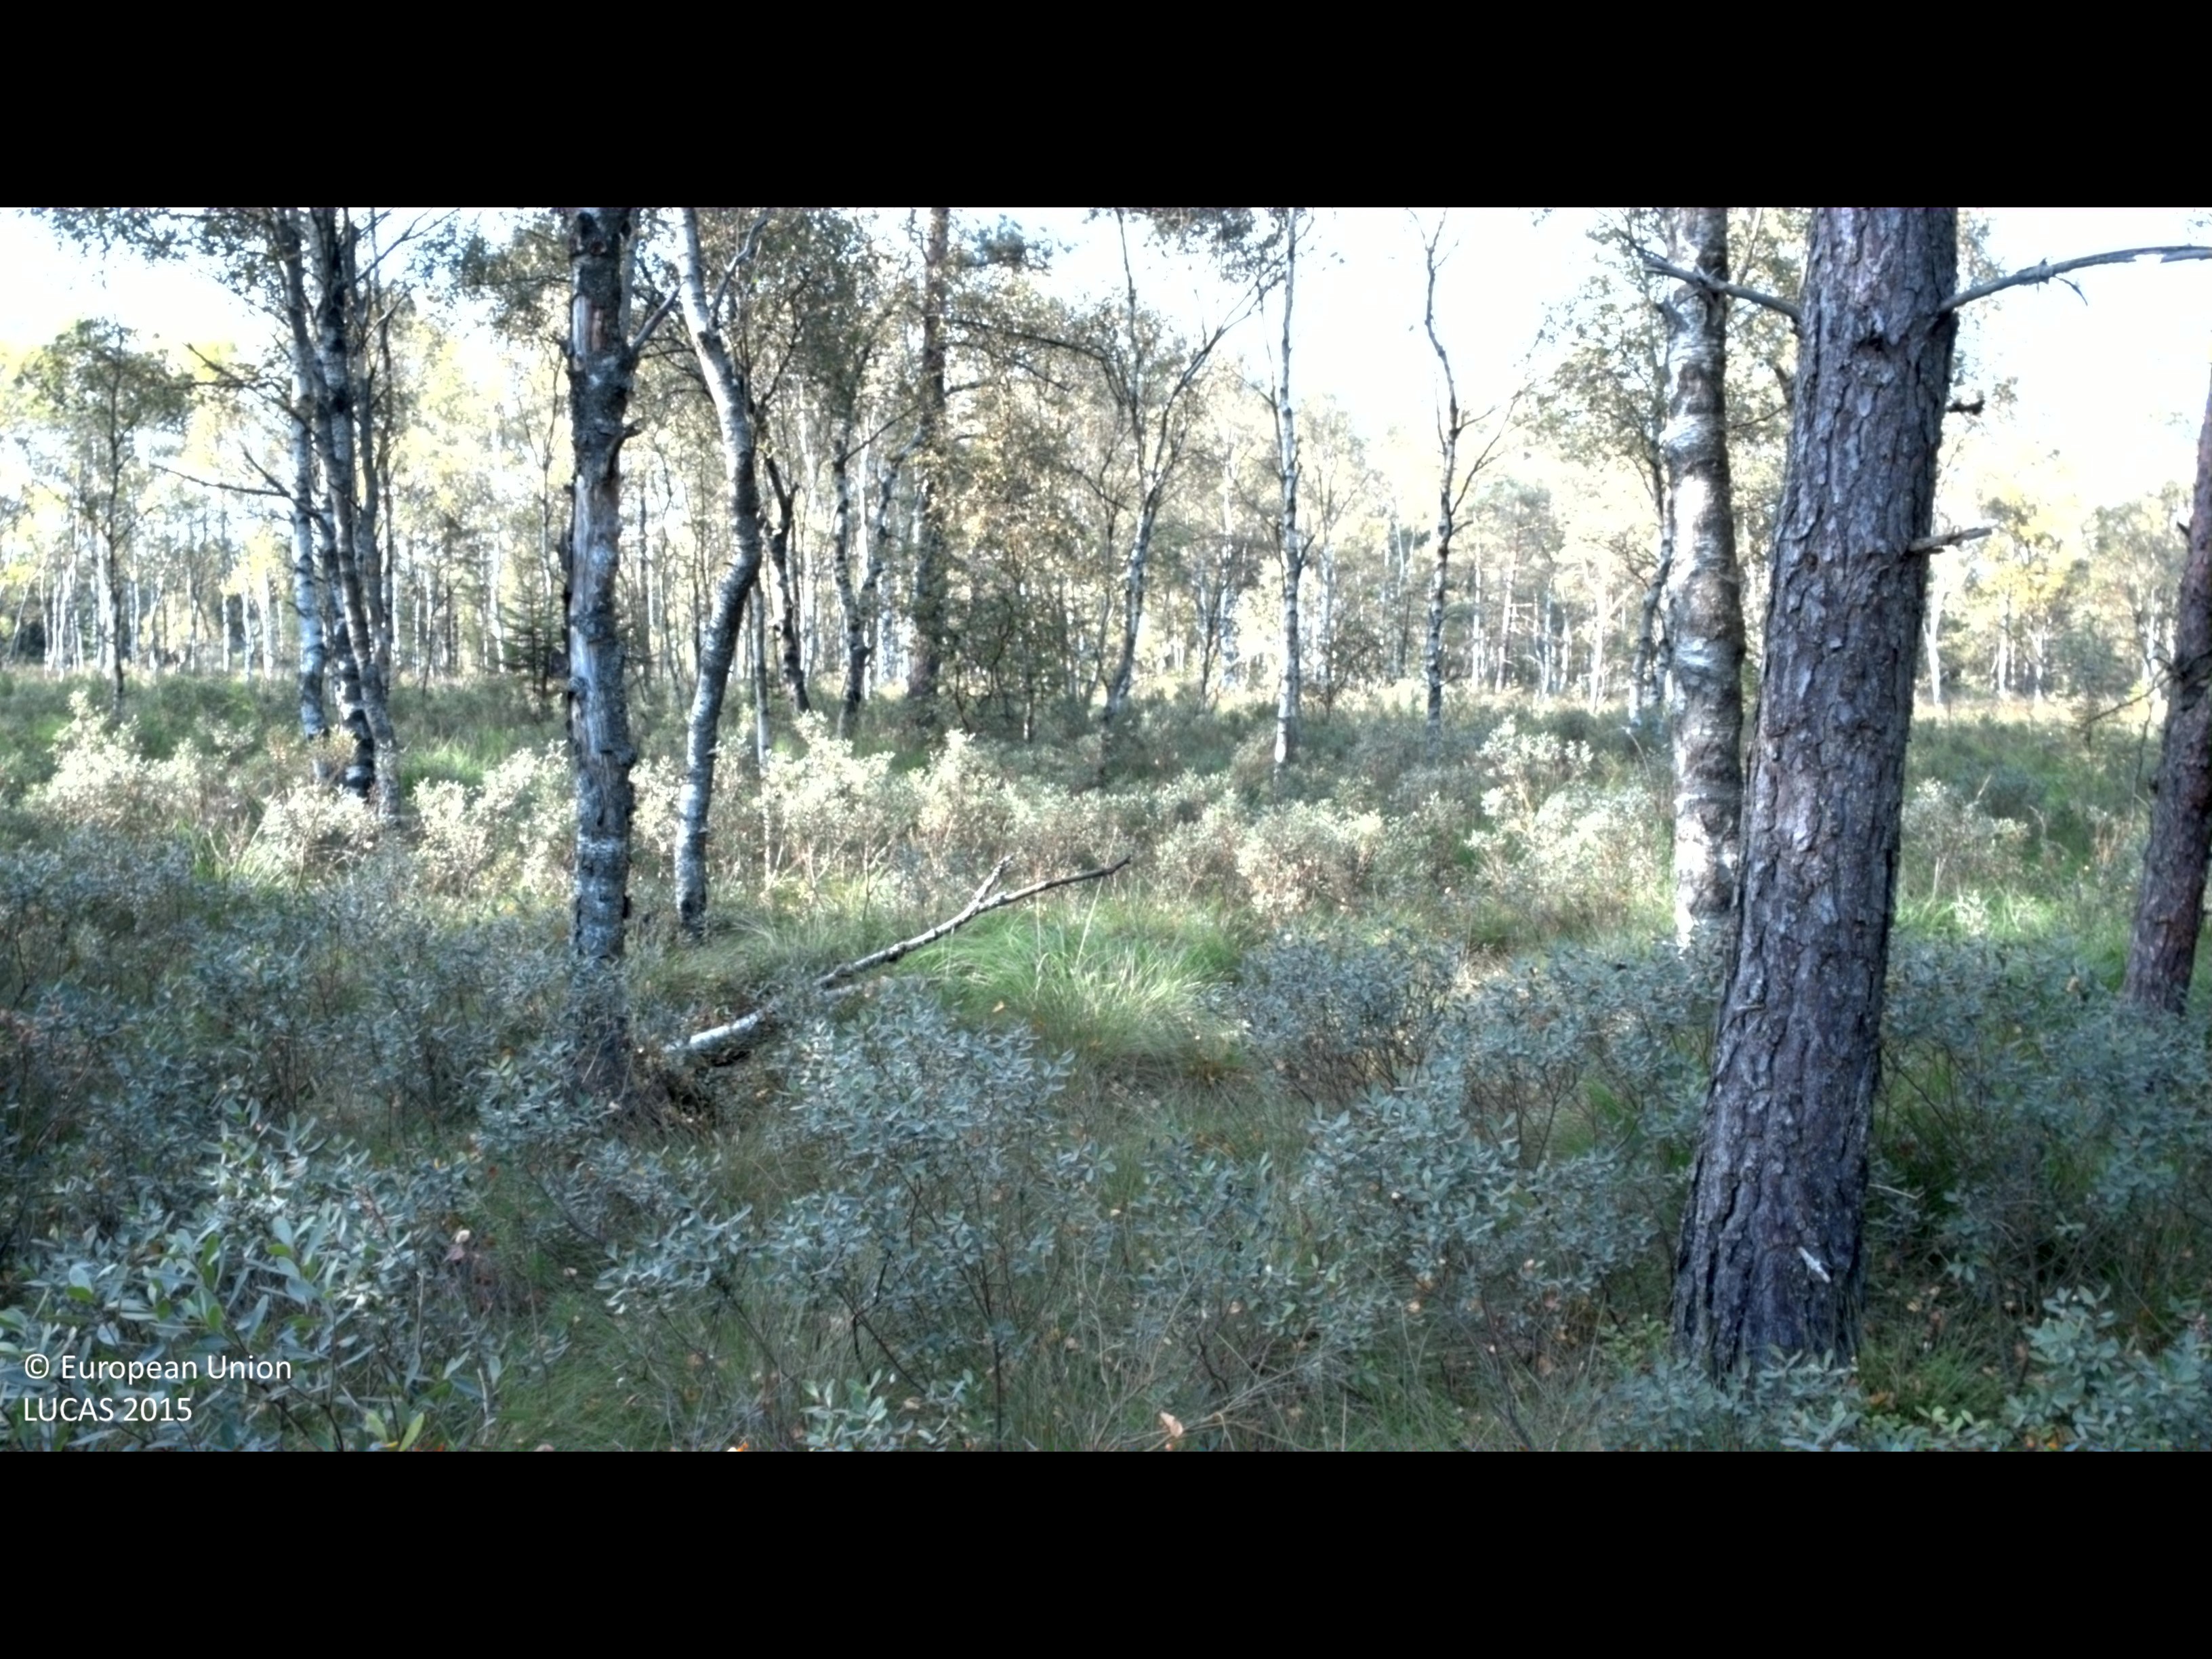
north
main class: Woodland
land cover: Pine dominated mixed woodland
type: boreal forest
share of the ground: 50 - 75 %
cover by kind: broadleaved forest trees 40 %, shrubs 25 %, herbaceous plants 20 %, coniferous forest trees 15 %
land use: Semi-natural and natural areas not in use
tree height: > 5 m
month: August
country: SE
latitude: 56.7233
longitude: 13.2160
